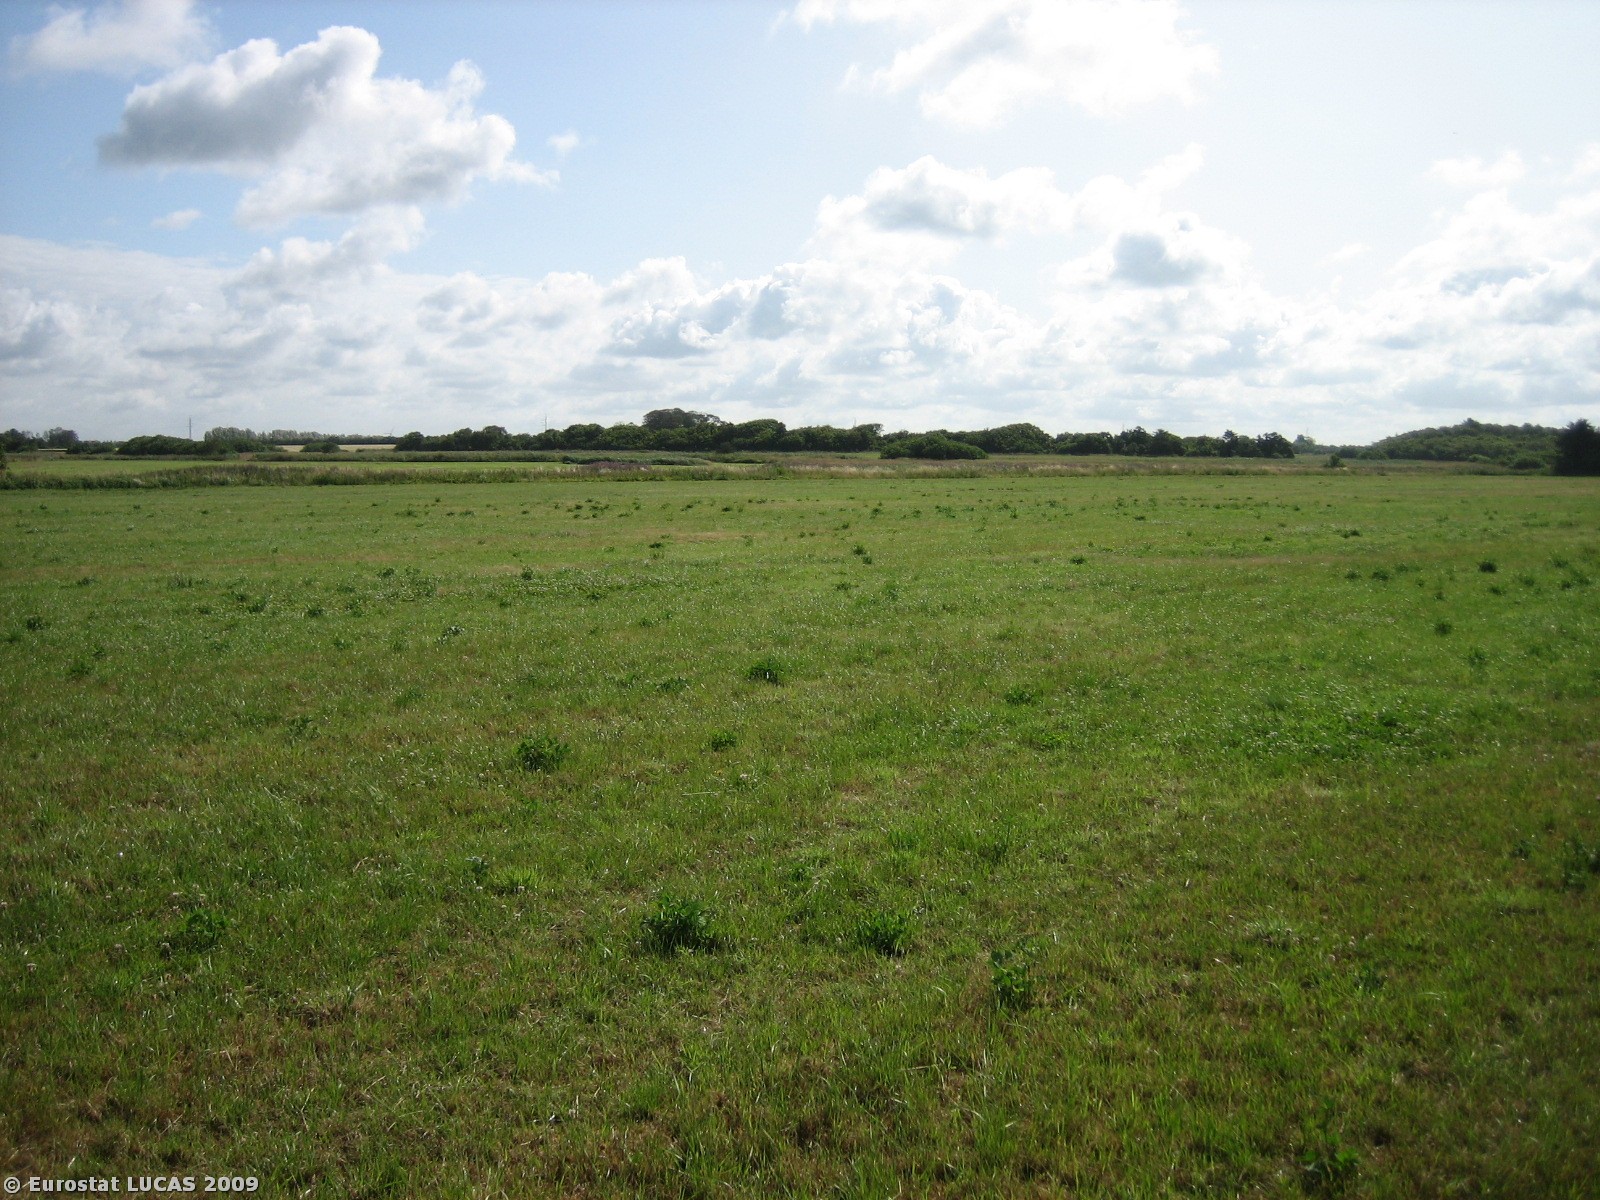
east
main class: Grassland
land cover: Grassland without tree/shrub cover
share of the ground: > 75 %
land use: Agriculture (excluding fallow land and kitchen gardens)
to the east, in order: Grassland without tree/shrub cover; Grass margins; Ditches and canals; Grass margins; Grassland without tree/shrub cover
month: July
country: DK
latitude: 55.7270
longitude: 8.2979
